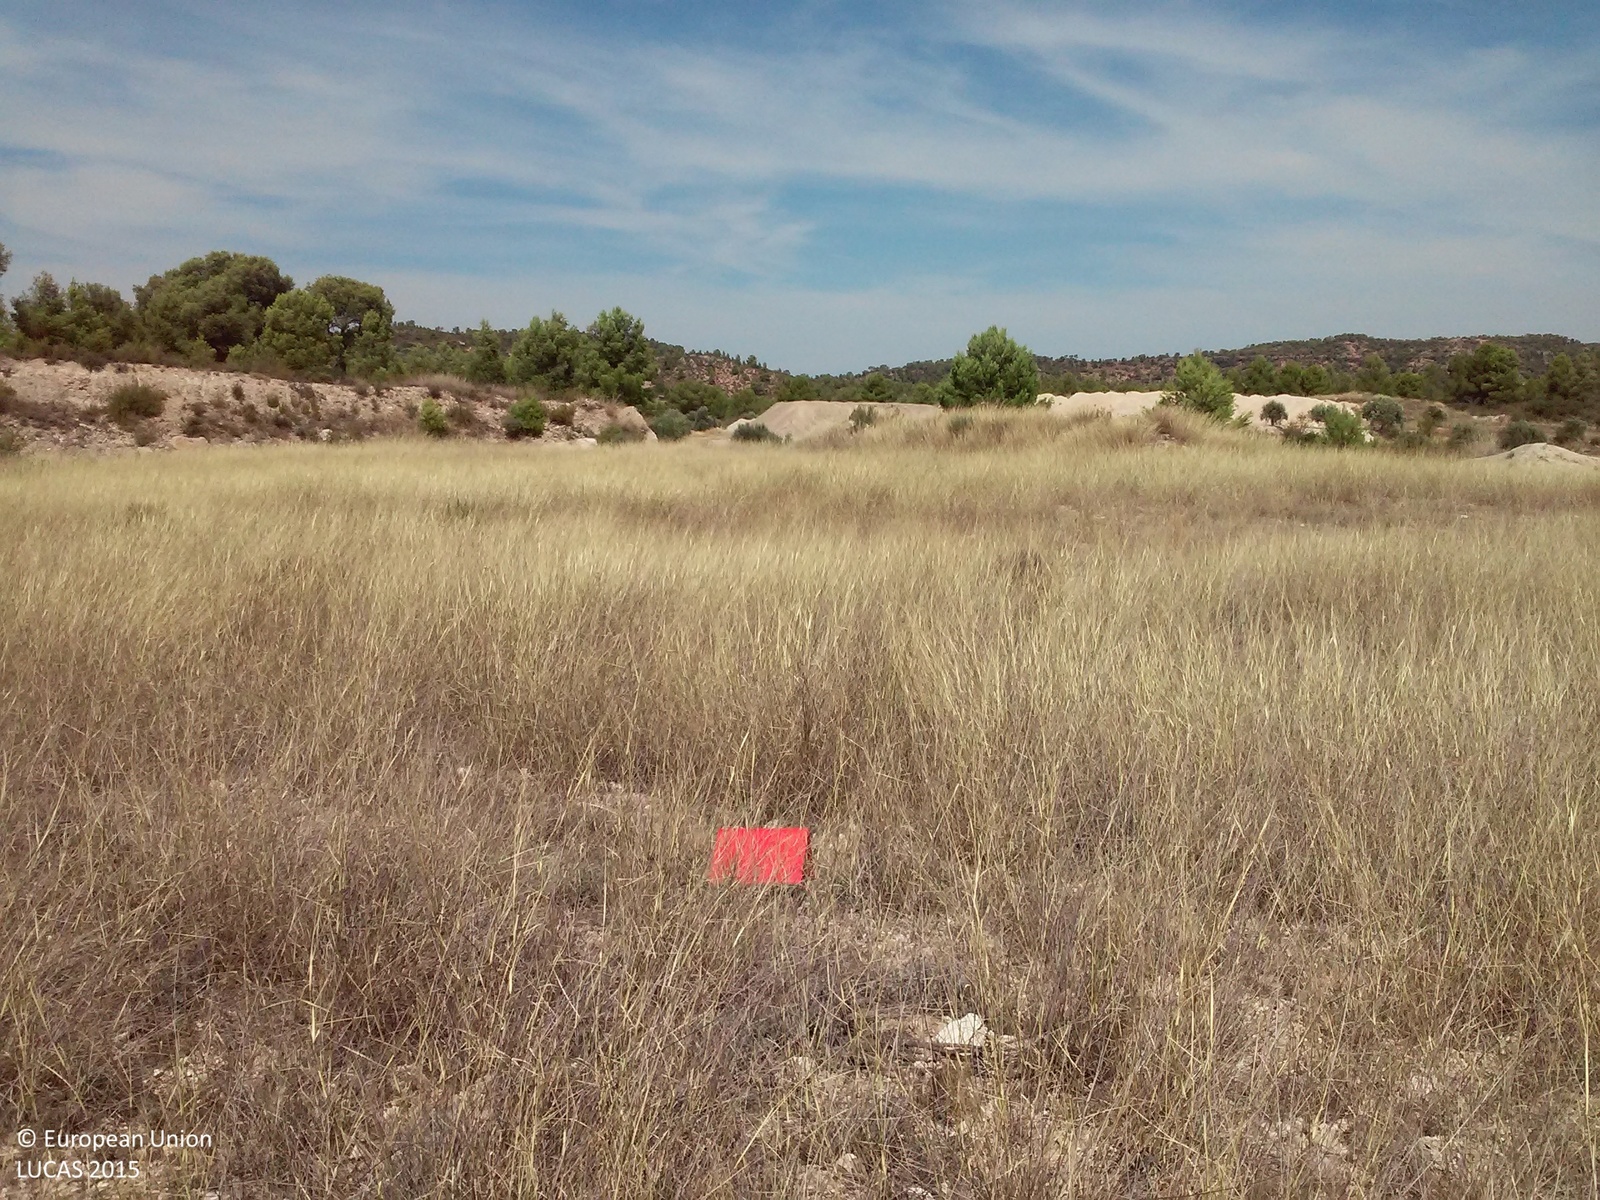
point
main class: Grassland
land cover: Grassland without tree/shrub cover
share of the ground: > 75 %
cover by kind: herbaceous plants 95 %, shrubs 5 %
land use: Abandoned areas
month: August
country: ES
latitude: 41.2479
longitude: 0.5511
